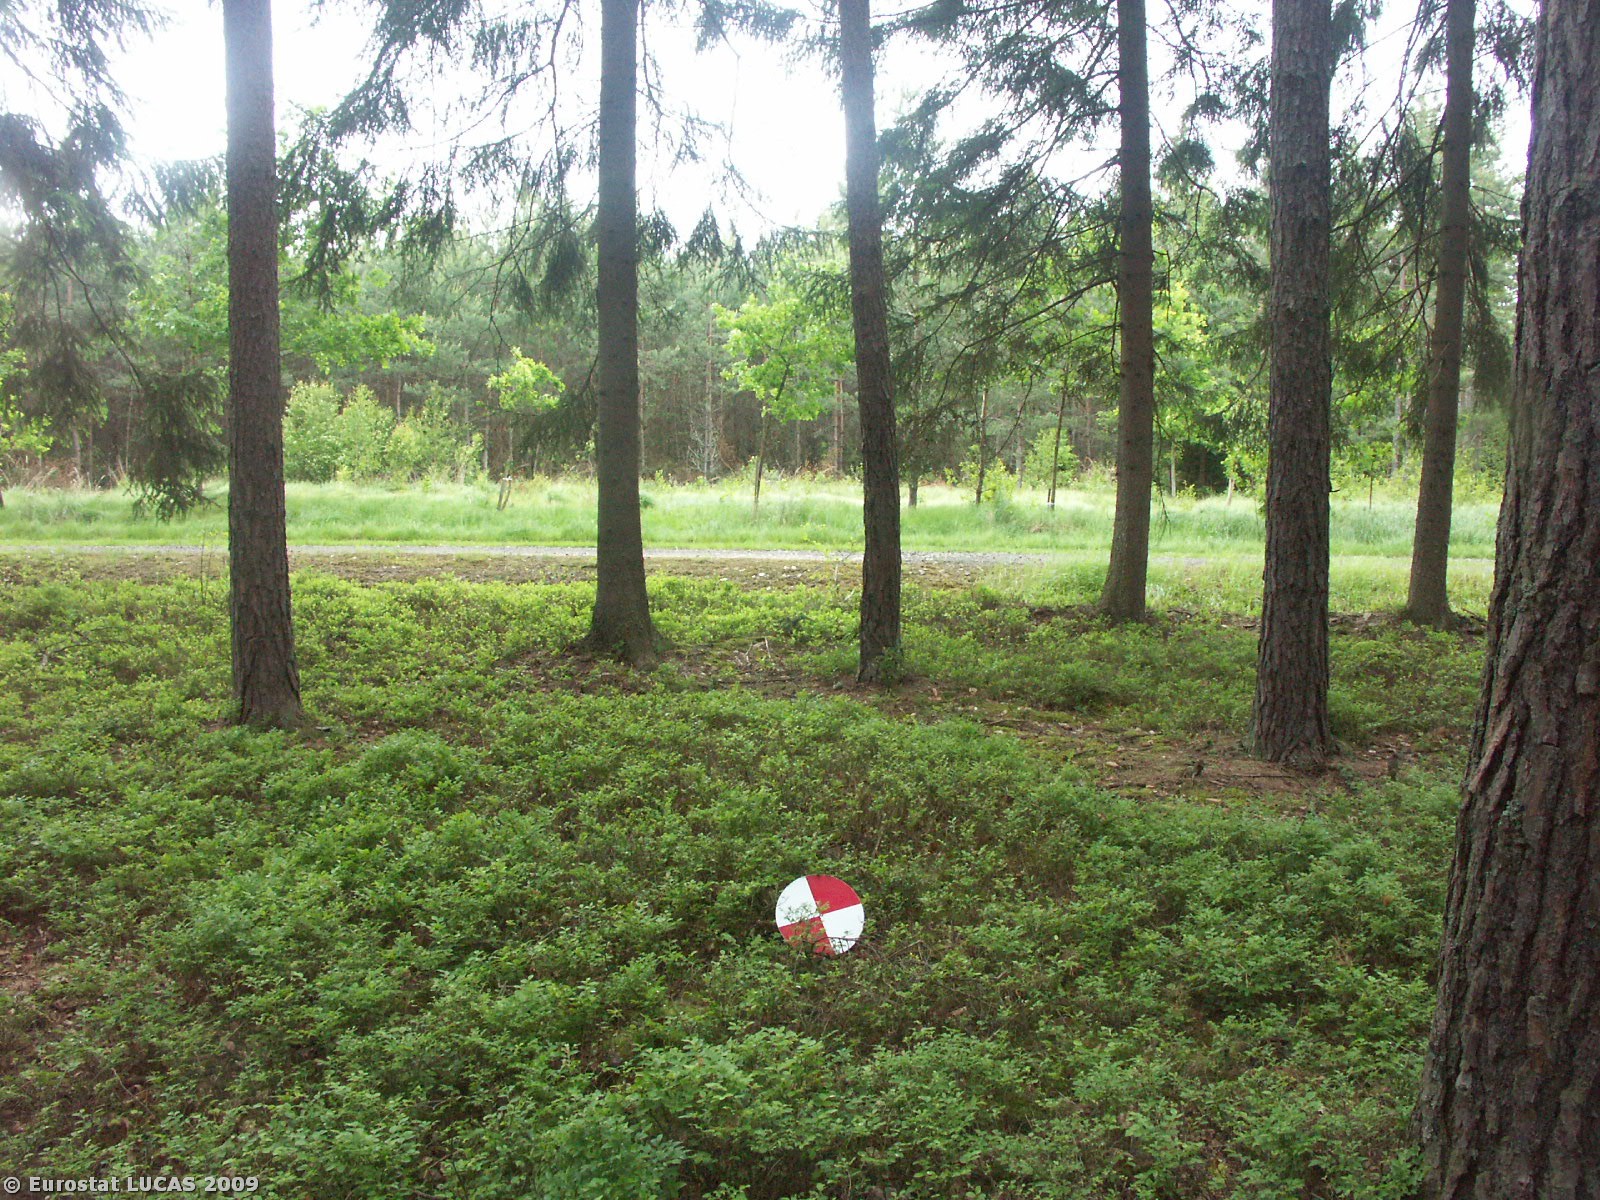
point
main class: Woodland
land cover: Mixed woodland
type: hemiboreal forest and nemoral coniferous forest and mixed broadleaved-coniferous forest
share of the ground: > 75 %
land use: Forestry
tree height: > 5 m
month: May
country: CZ
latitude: 49.0068
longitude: 14.6905
